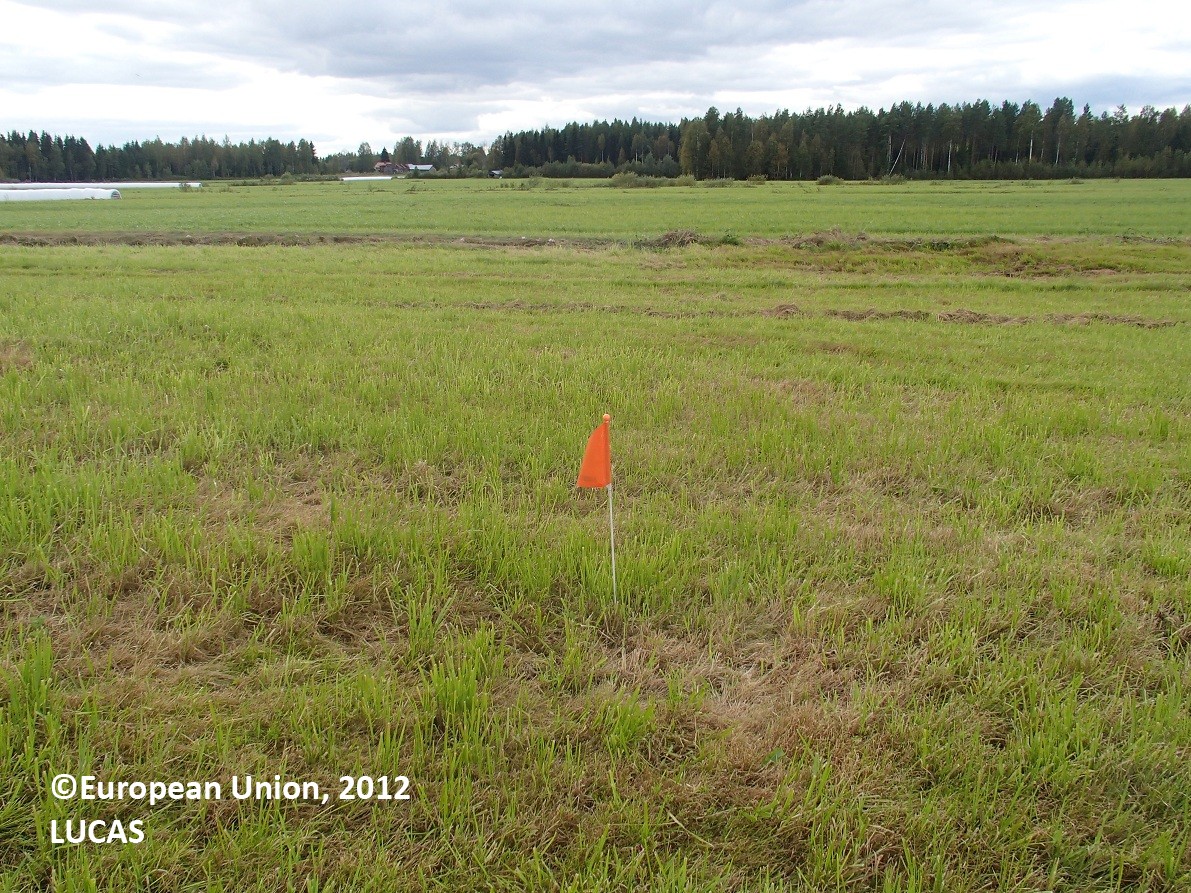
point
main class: Cropland
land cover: Temporary grasslands
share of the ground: > 75 %
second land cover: Barley
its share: < 10 %
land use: Agriculture (excluding fallow land and kitchen gardens)
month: August
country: FI
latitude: 63.6680
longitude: 26.7203
